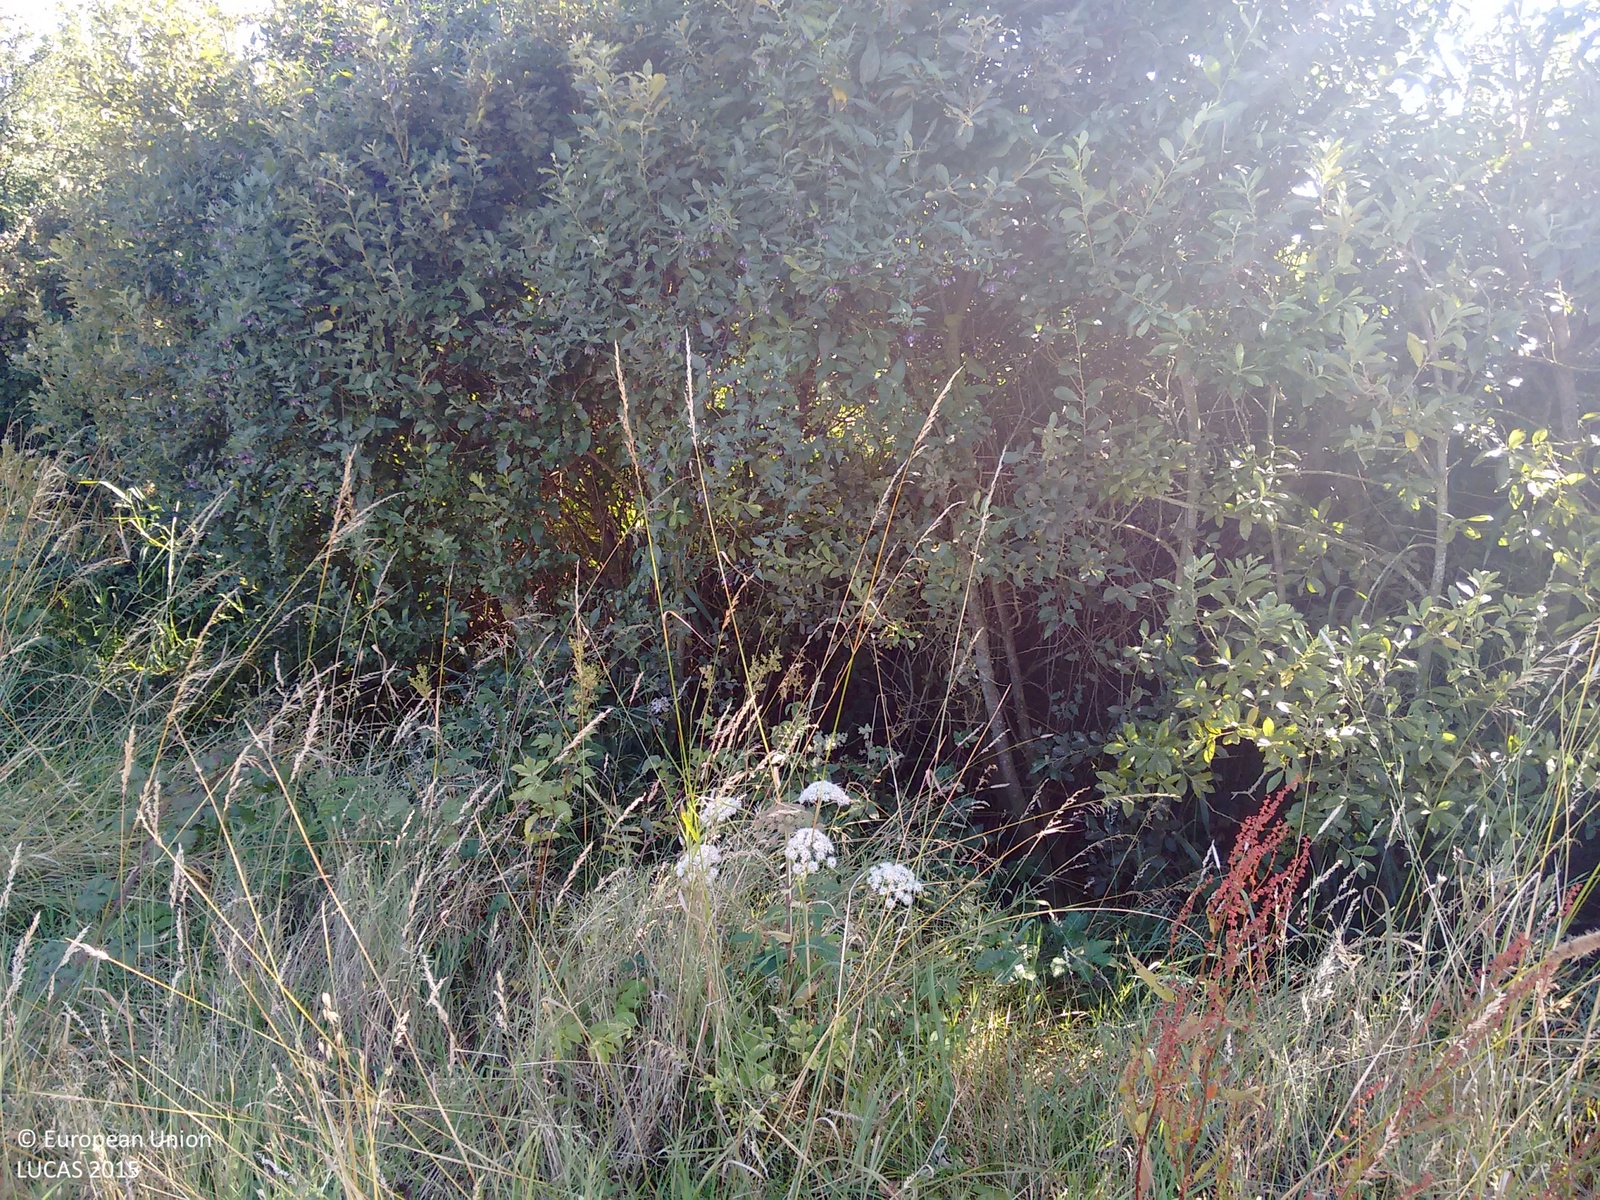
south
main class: Cropland
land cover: Oats
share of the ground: > 75 %
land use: Agriculture (excluding fallow land and kitchen gardens)
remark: Harvested field
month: August
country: IE
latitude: 53.8509
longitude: -6.2785
